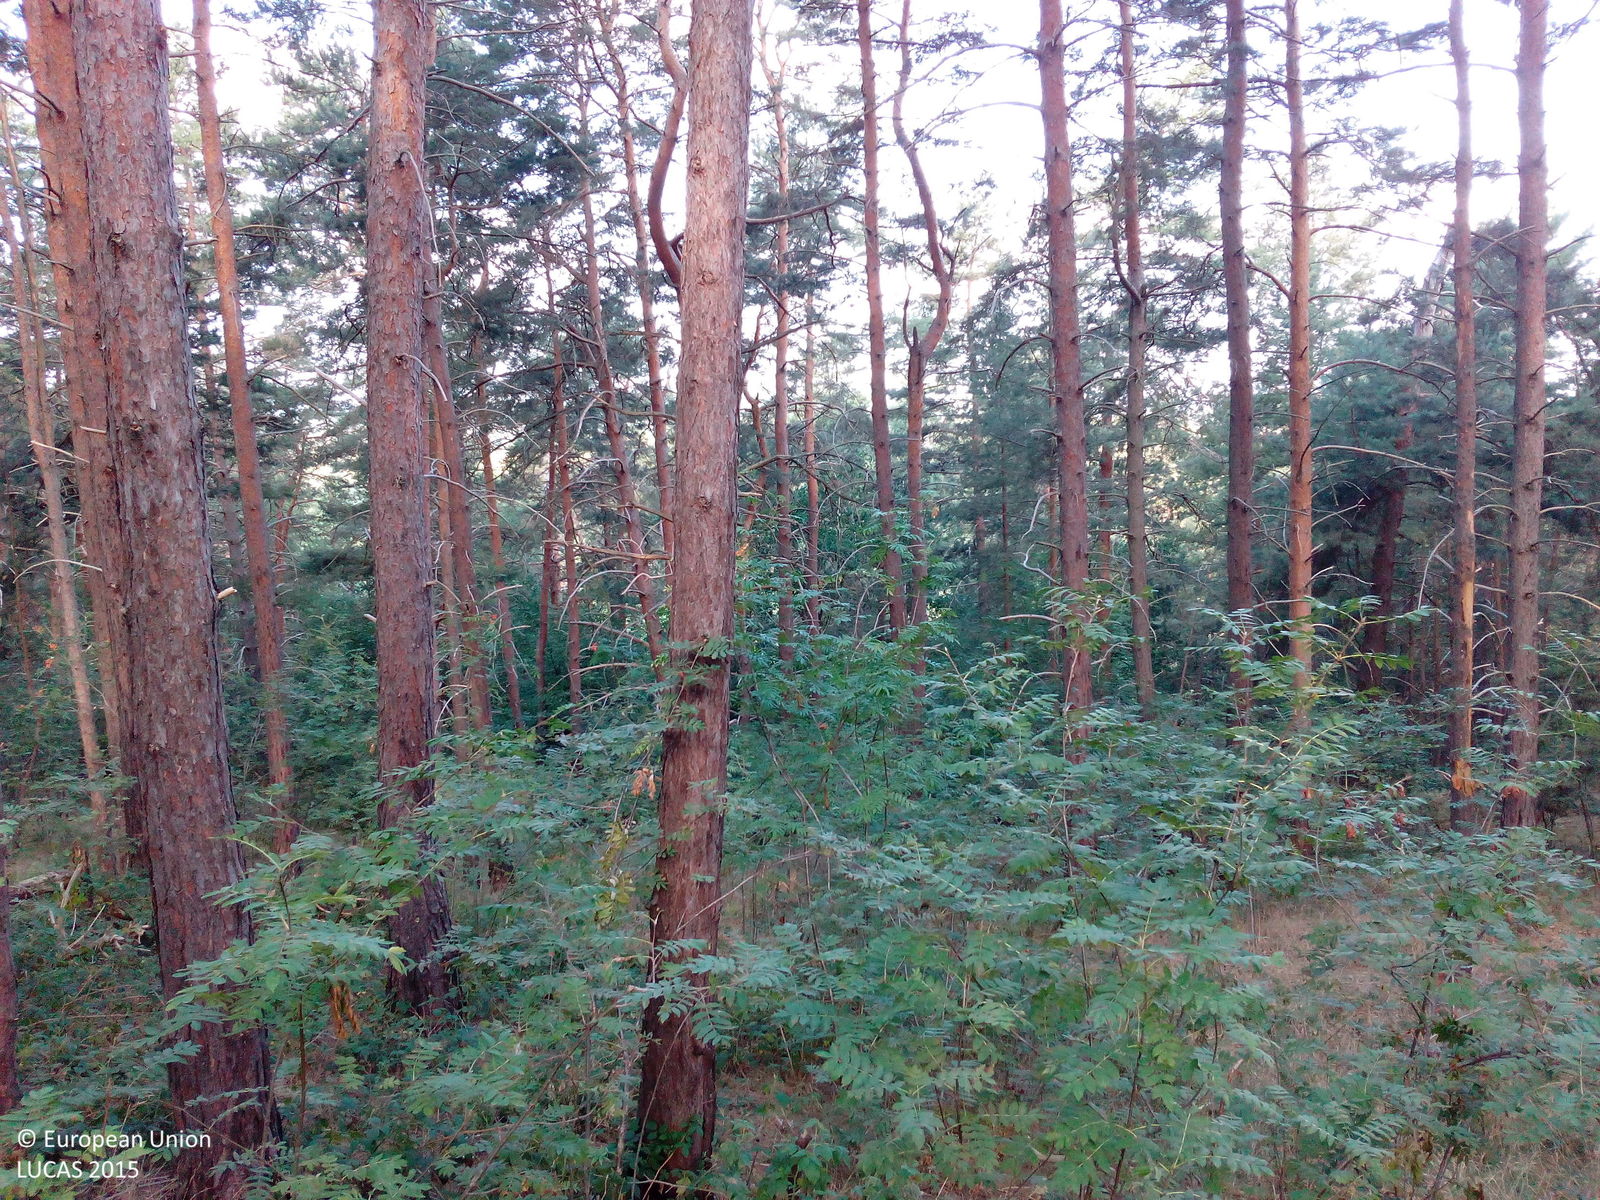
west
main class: Woodland
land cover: Pine dominated coniferous woodland
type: hemiboreal forest and nemoral coniferous forest and mixed broadleaved-coniferous forest
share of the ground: > 75 %
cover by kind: coniferous forest trees 90 %, herbaceous plants 10 %
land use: Forestry
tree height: > 5 m
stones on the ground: < 10 %
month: August
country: DE
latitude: 51.8165
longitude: 10.9426
